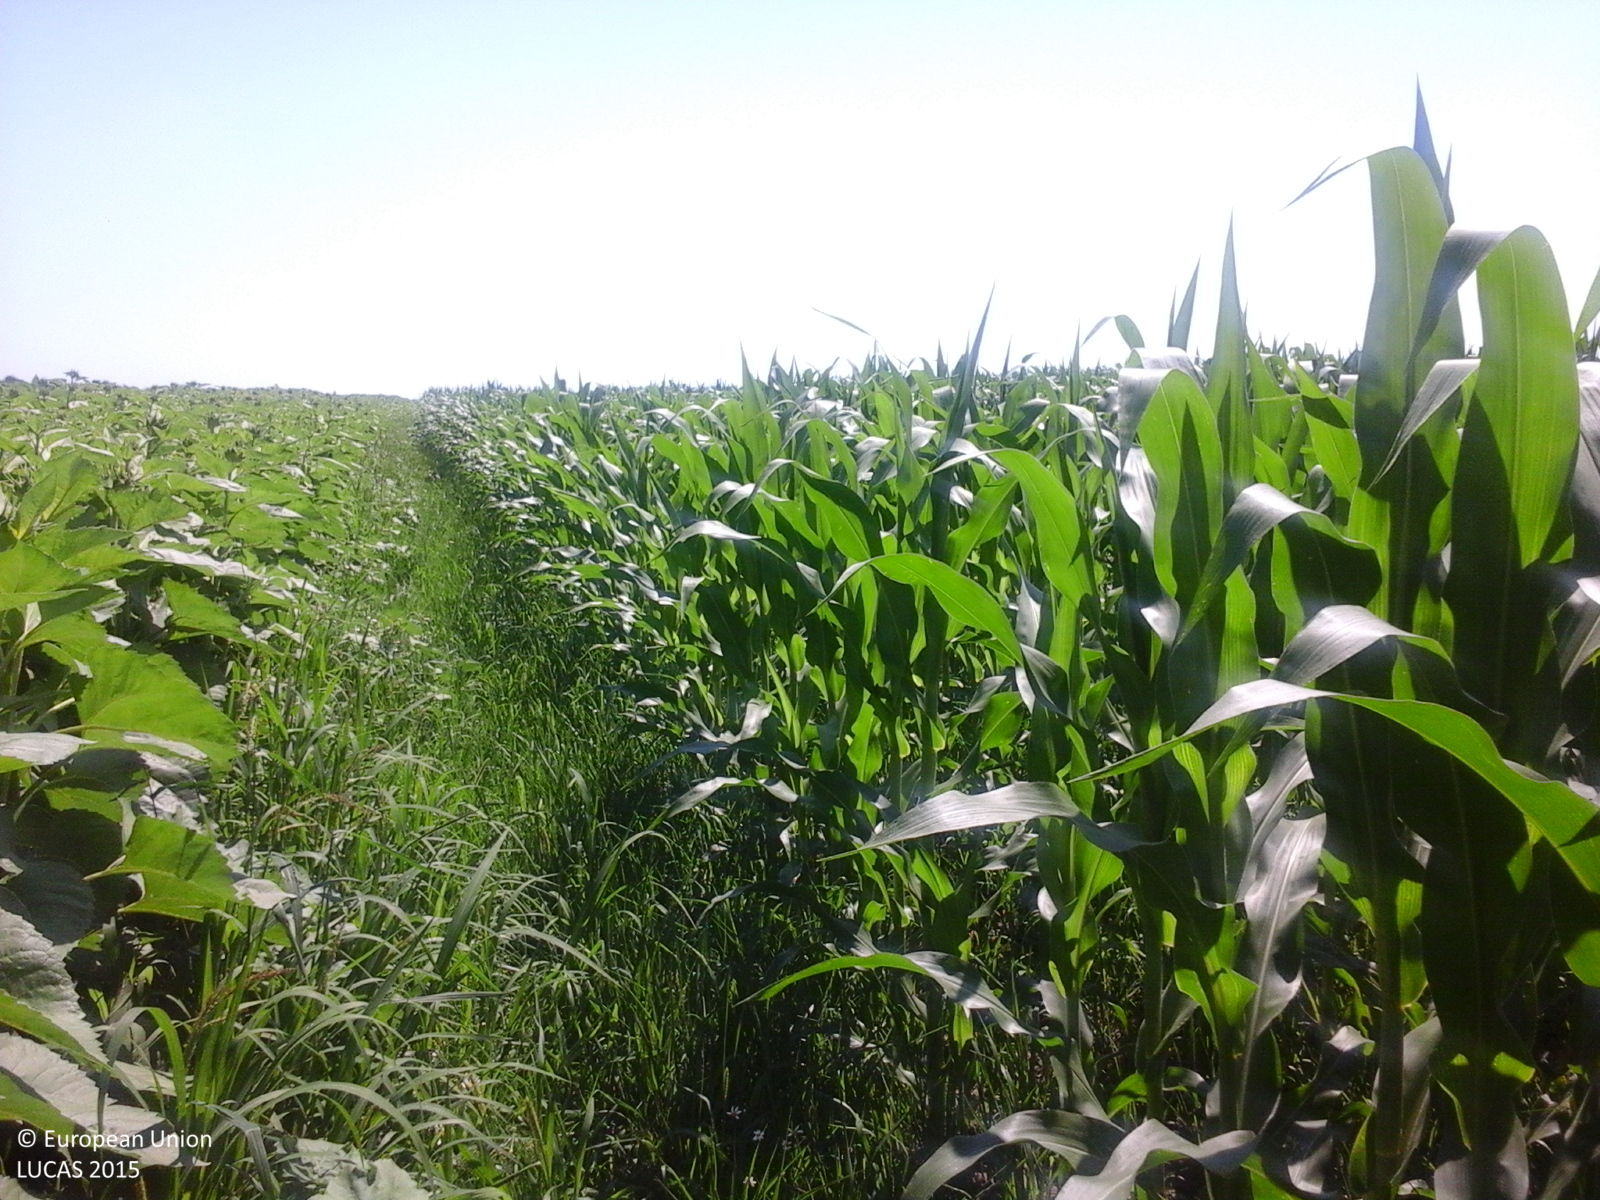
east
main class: Cropland
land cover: Sunflower
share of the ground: > 75 %
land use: Agriculture (excluding fallow land and kitchen gardens)
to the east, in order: Sunflower; Grass margins; Tracks; Grass margins; Spontaneously vegetated surfaces; Maize
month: July
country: RO
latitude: 44.4905
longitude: 24.5456
